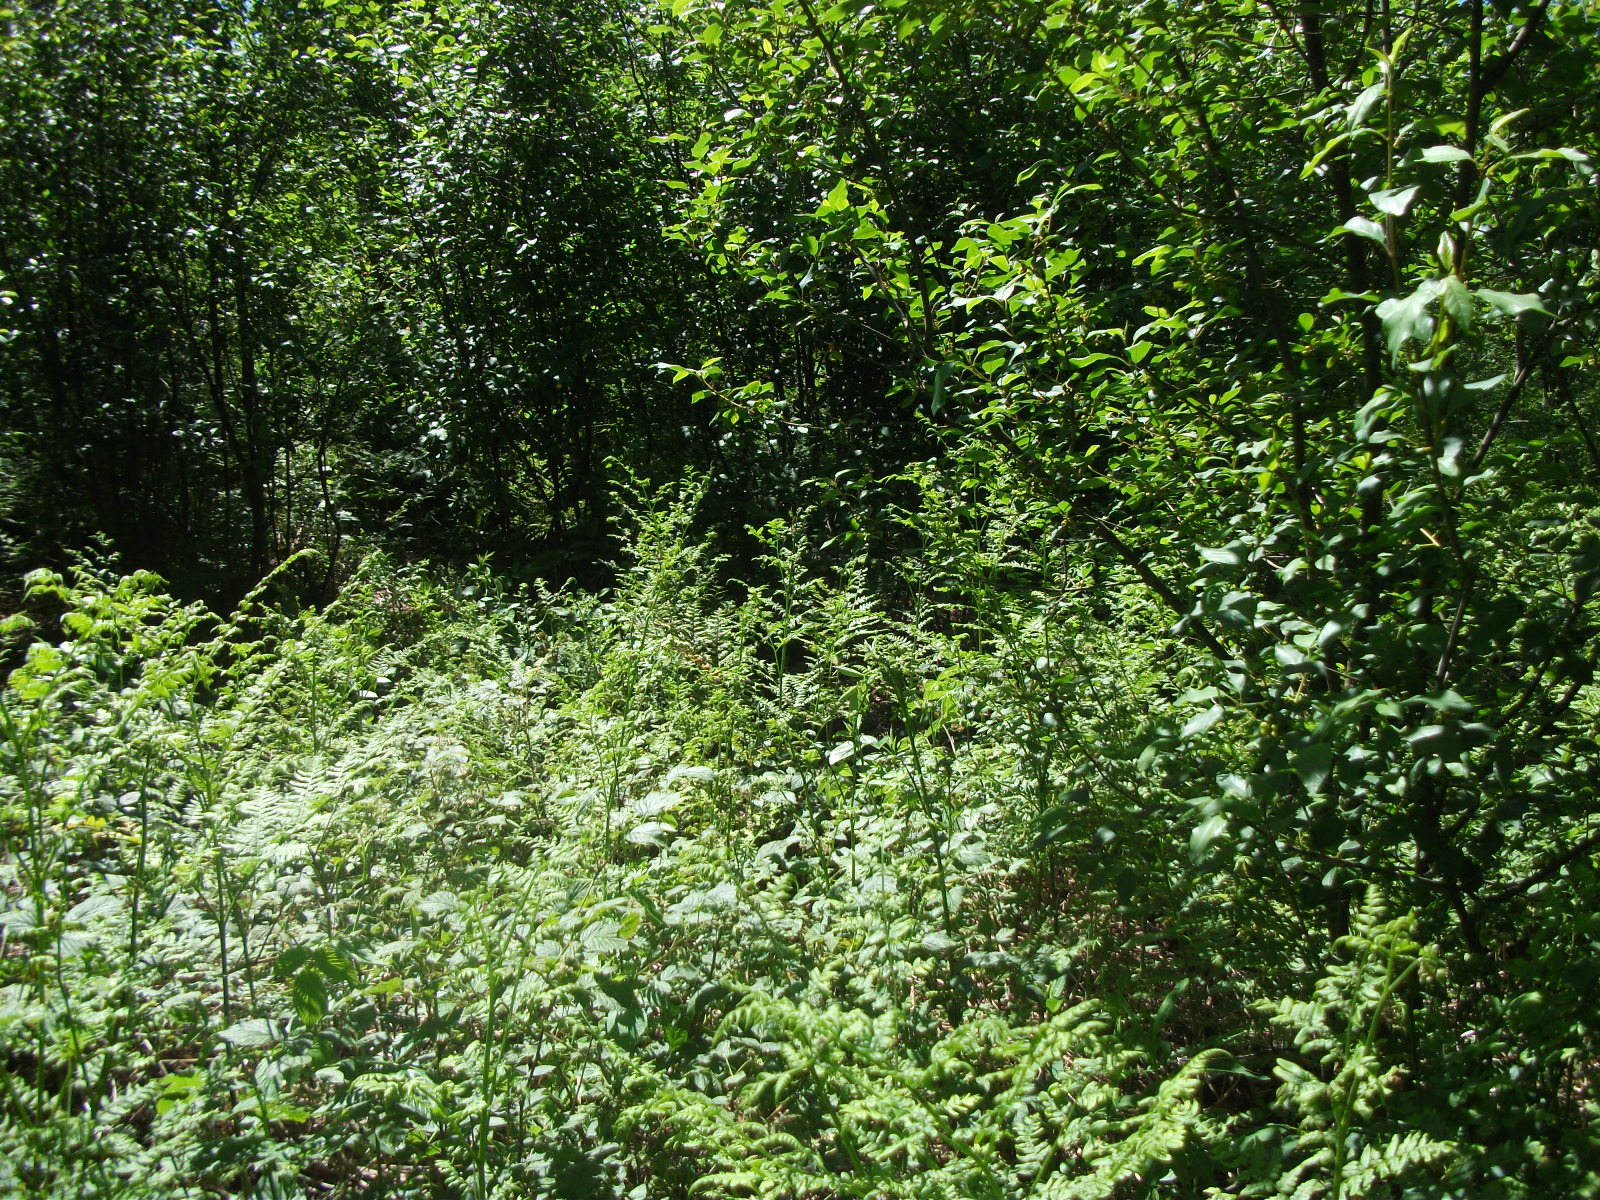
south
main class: Woodland
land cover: Broadleaved woodland
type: non-riverine alder, birch or aspen forest
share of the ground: > 75 %
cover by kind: broadleaved forest trees 90 %, shrubs 5 %, herbaceous plants 5 %
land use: Forestry
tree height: < 5 m
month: July
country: LV
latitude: 56.8028
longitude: 26.2028
